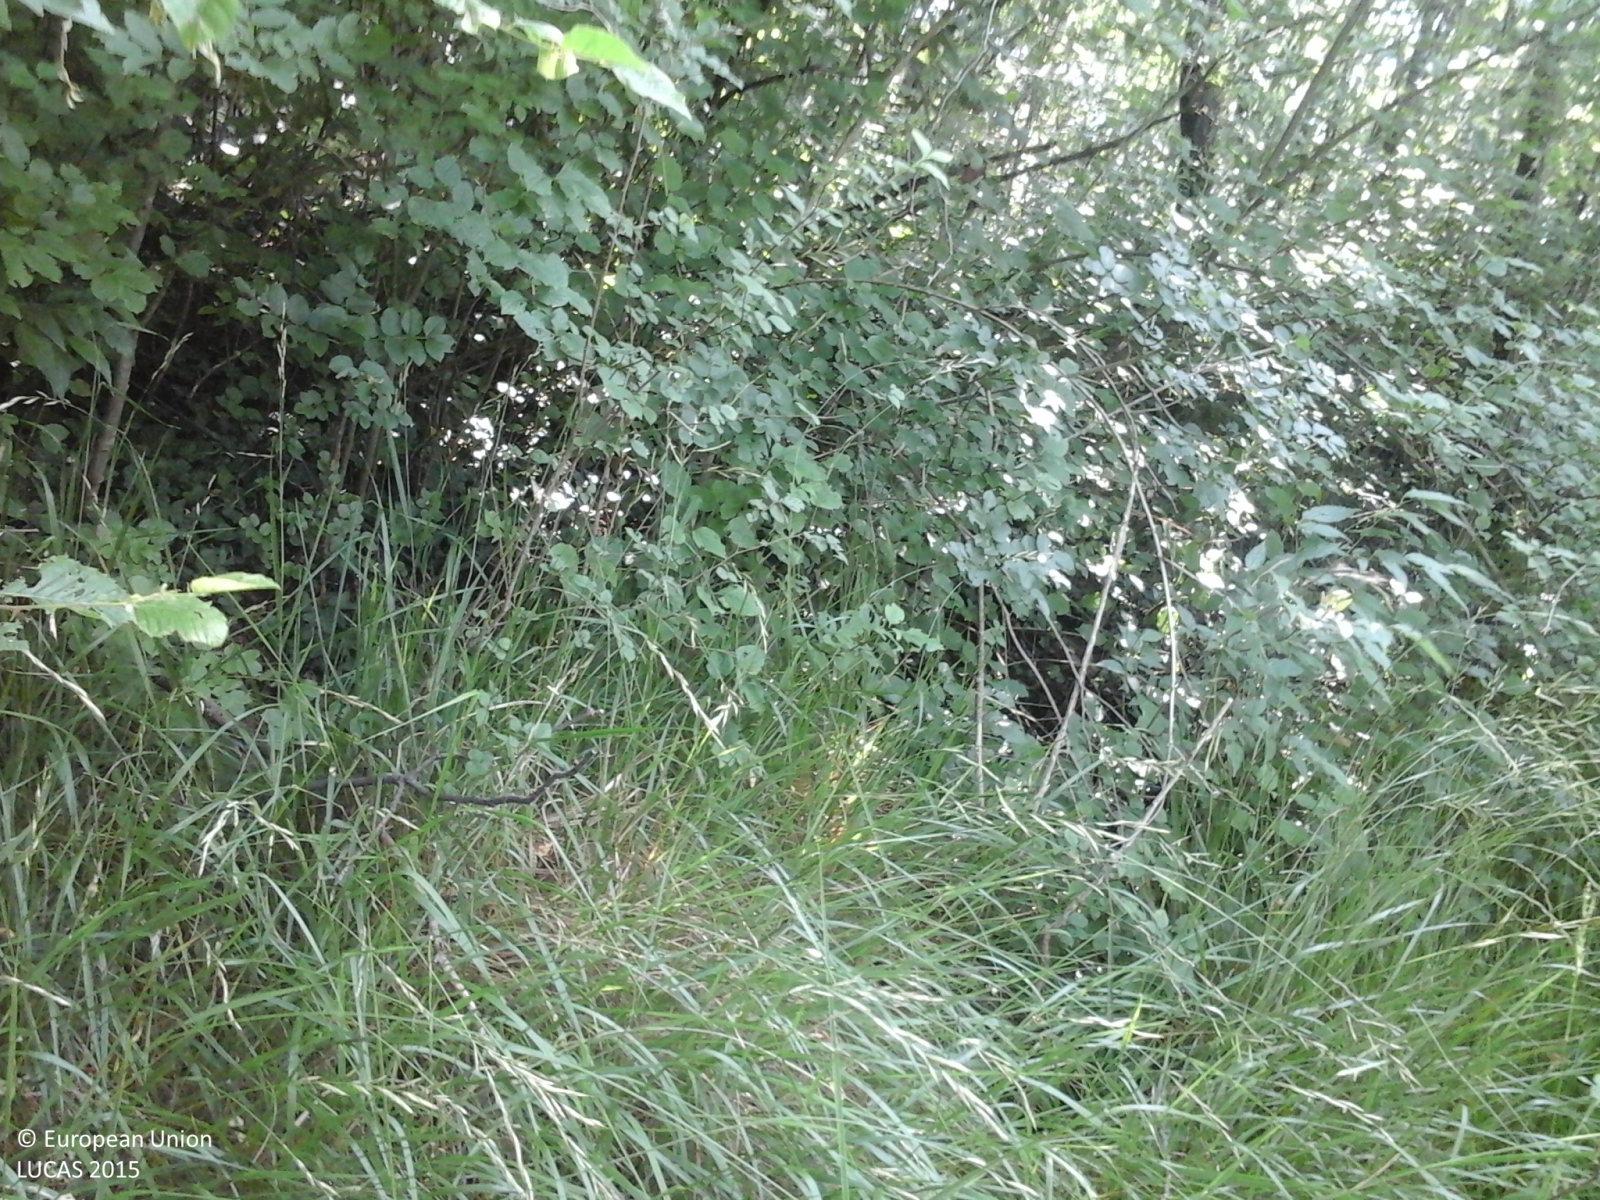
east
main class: Woodland
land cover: Broadleaved woodland
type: thermophilous deciduous forest
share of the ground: > 75 %
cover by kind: broadleaved forest trees 100 %
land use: Semi-natural and natural areas not in use
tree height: > 5 m
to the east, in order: Broadleaved woodland; Paved roads, cycling and walking lanes; Broadleaved woodland; Paved roads, cycling and walking lanes; Broadleaved woodland
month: June
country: IT
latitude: 45.8142
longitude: 11.7605
